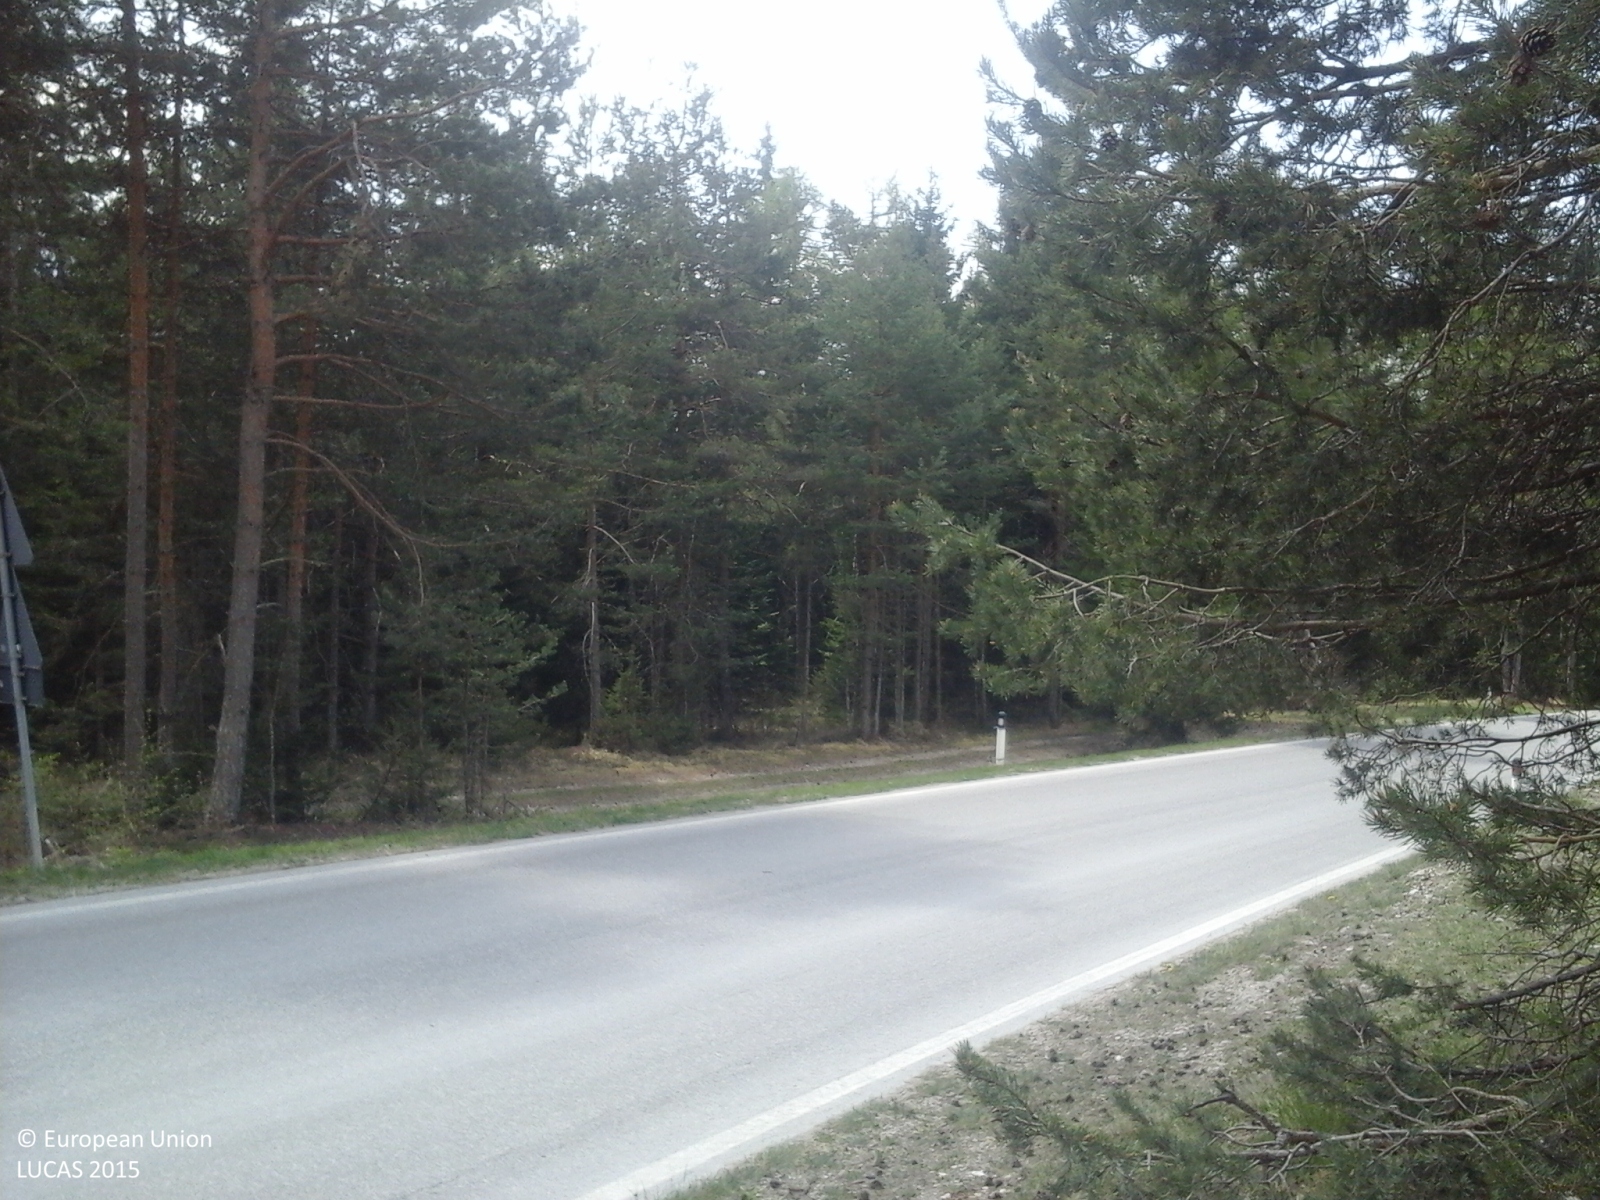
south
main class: Woodland
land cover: Pine dominated coniferous woodland
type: alpine coniferous forest
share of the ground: 50 - 75 %
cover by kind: coniferous forest trees 60 %, herbaceous plants 35 %, shrubs 5 %
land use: Forestry
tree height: > 5 m
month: April
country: IT
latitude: 46.3452
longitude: 11.1290
